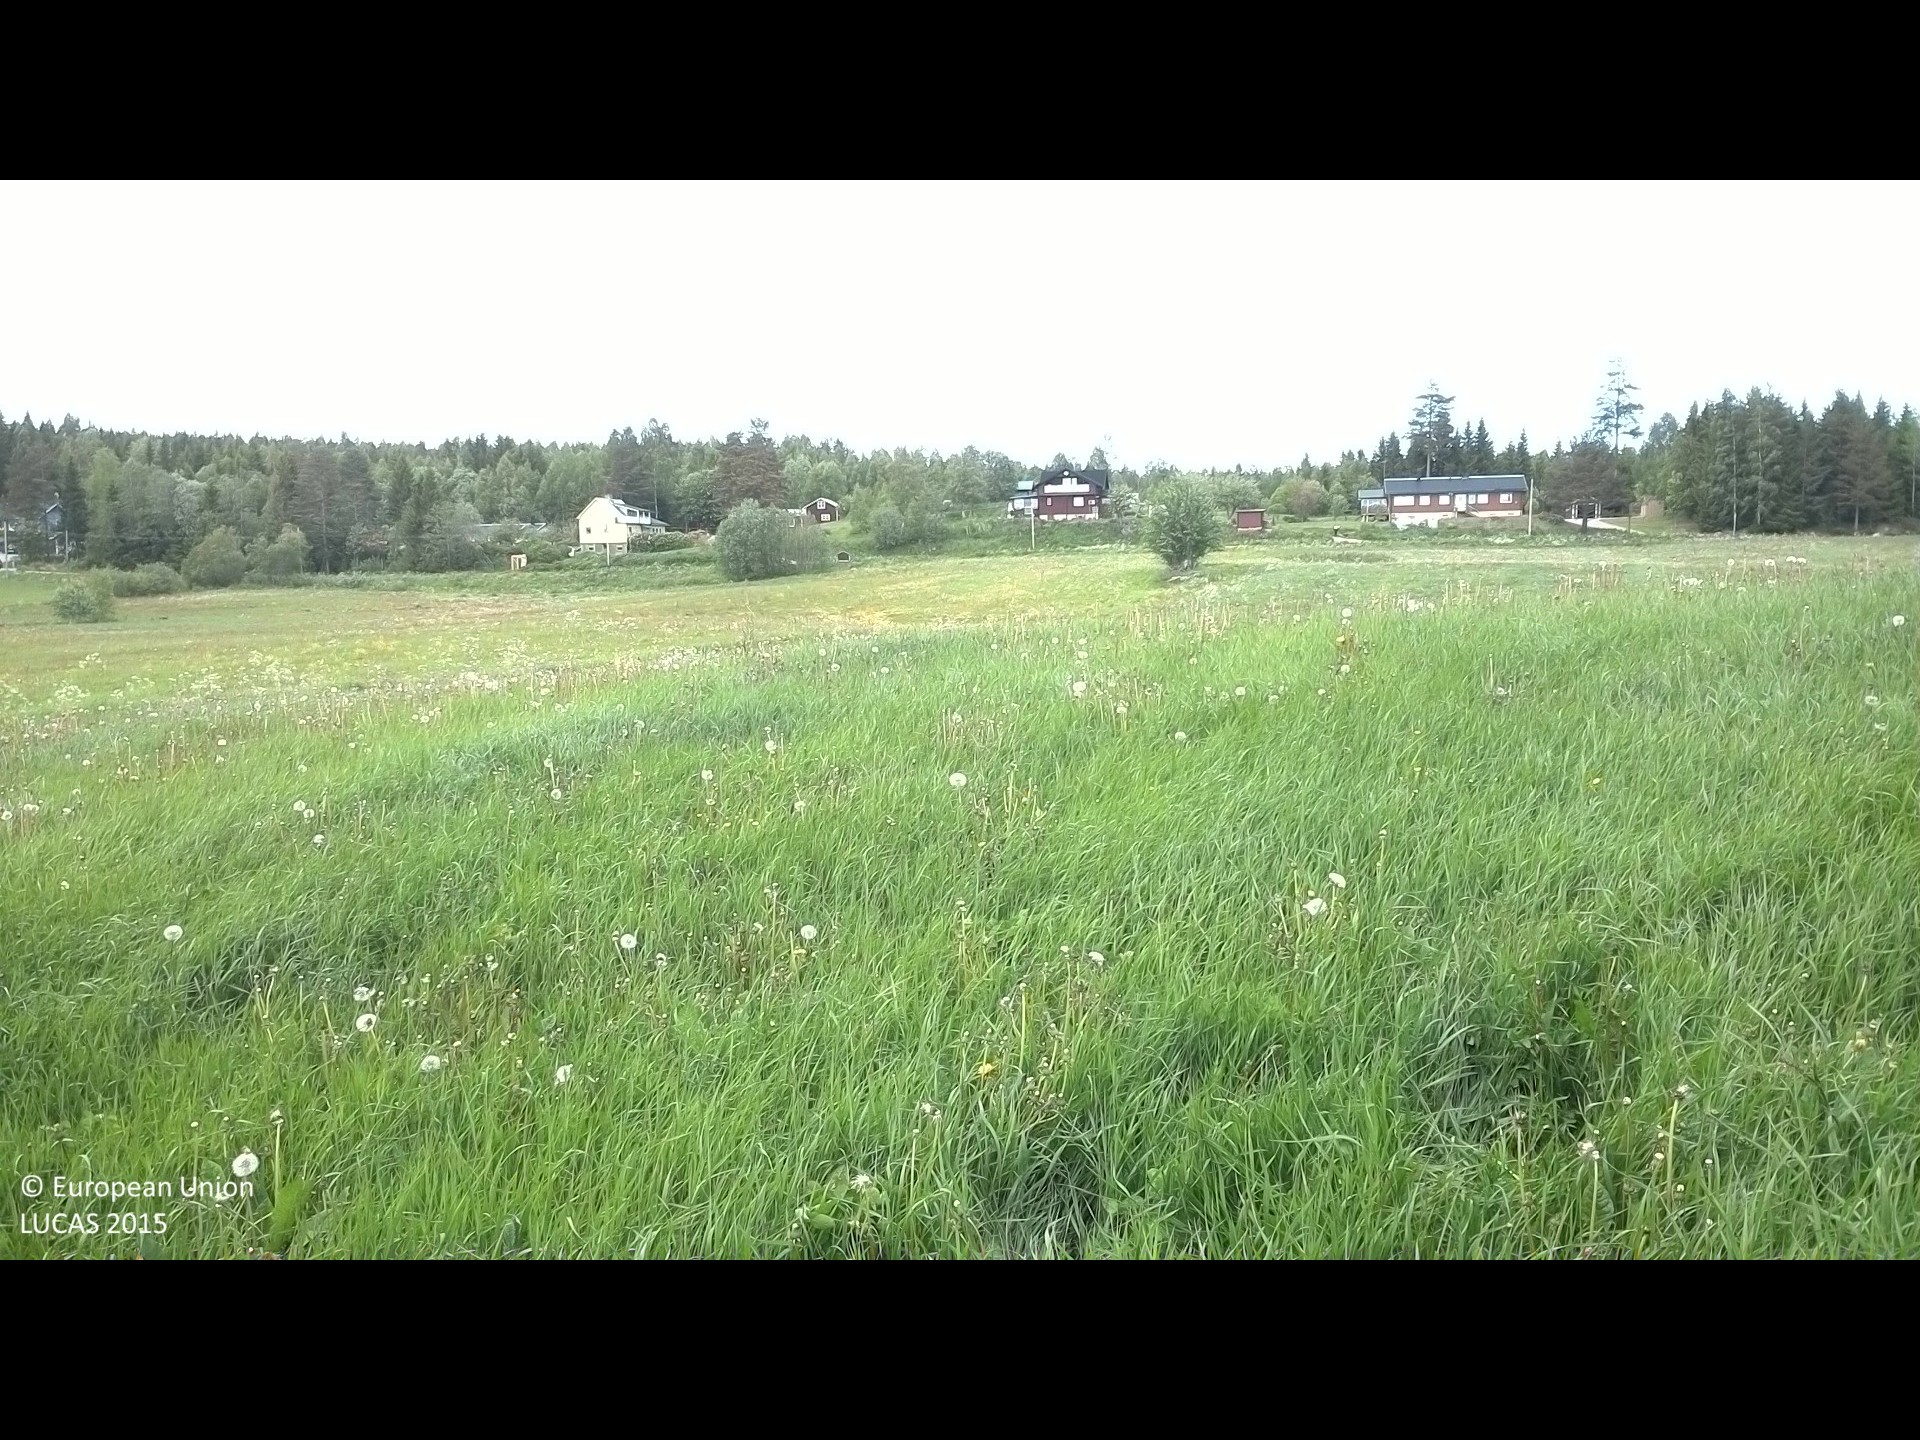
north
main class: Cropland
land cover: Other leguminous and mixtures for fodder
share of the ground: > 75 %
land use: Agriculture (excluding fallow land and kitchen gardens)
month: June
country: SE
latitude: 62.2533
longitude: 17.3169
